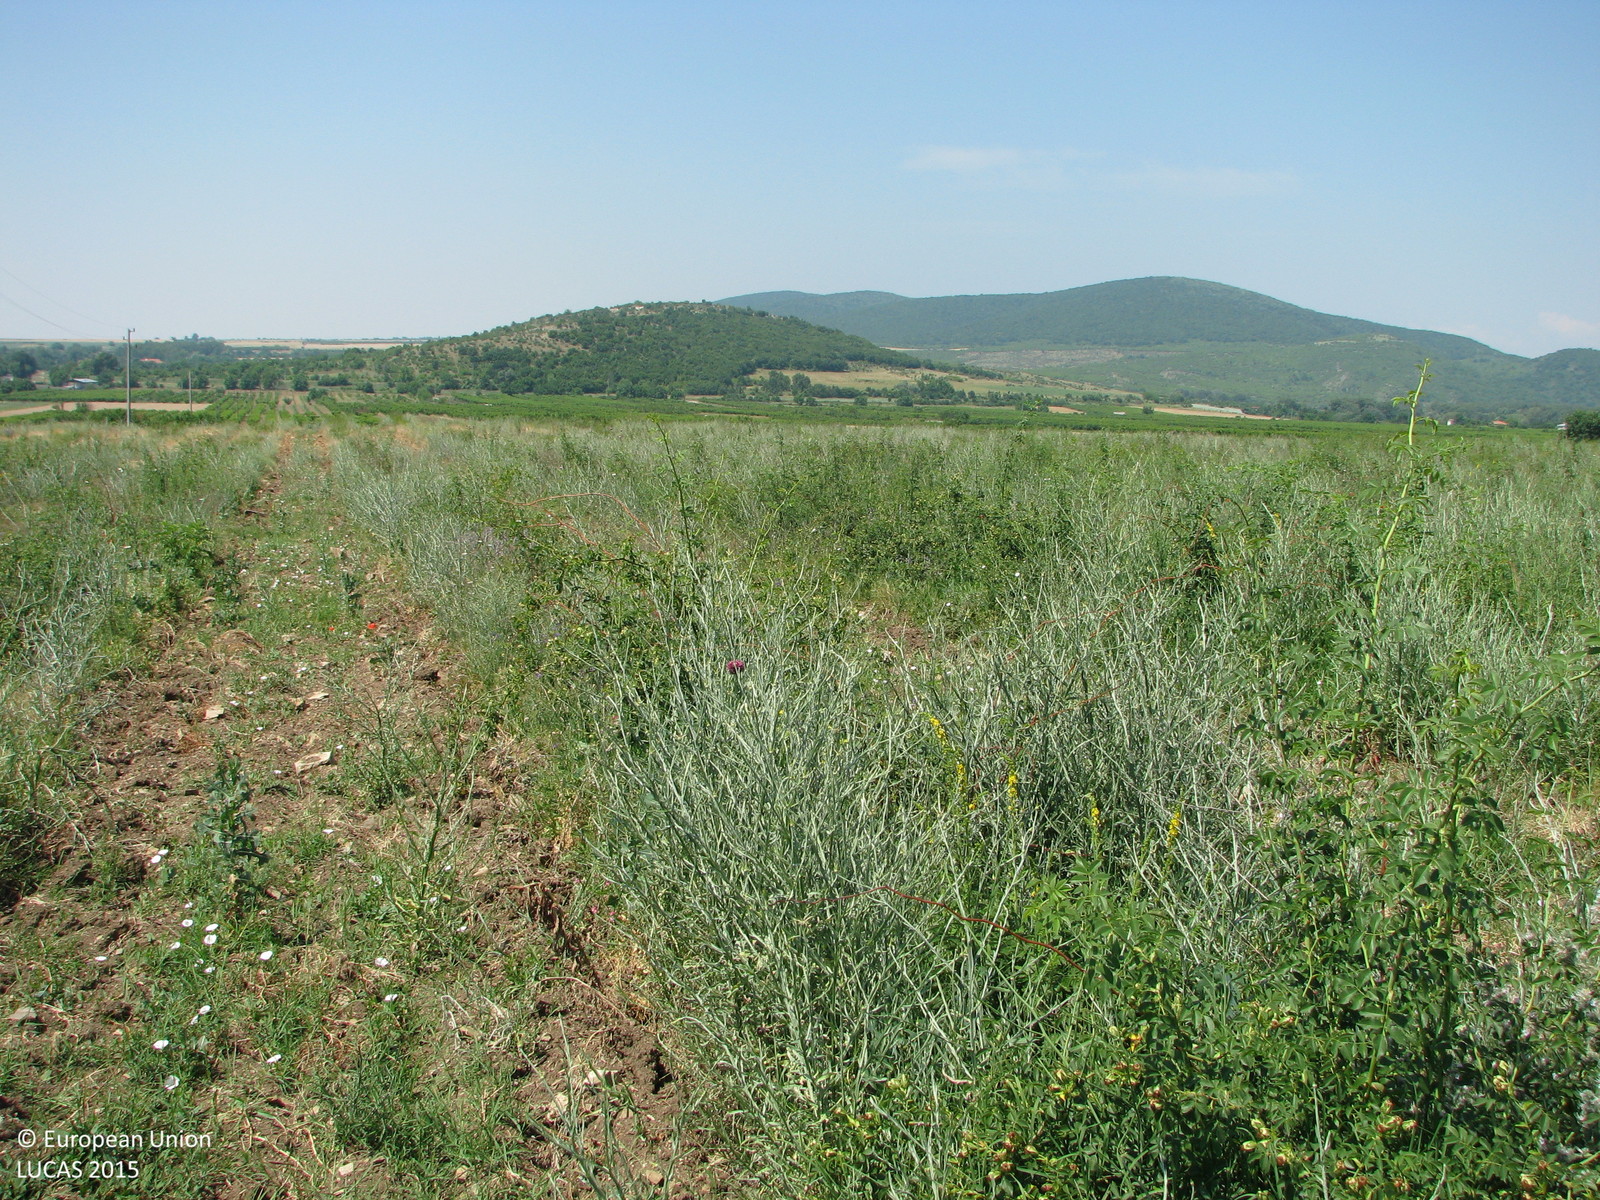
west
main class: Cropland
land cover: Other fruit trees and berries
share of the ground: < 10 %
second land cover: Spontaneously vegetated surfaces
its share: > 75 %
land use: Agriculture (excluding fallow land and kitchen gardens)
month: June
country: BG
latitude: 42.6059
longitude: 26.2131
